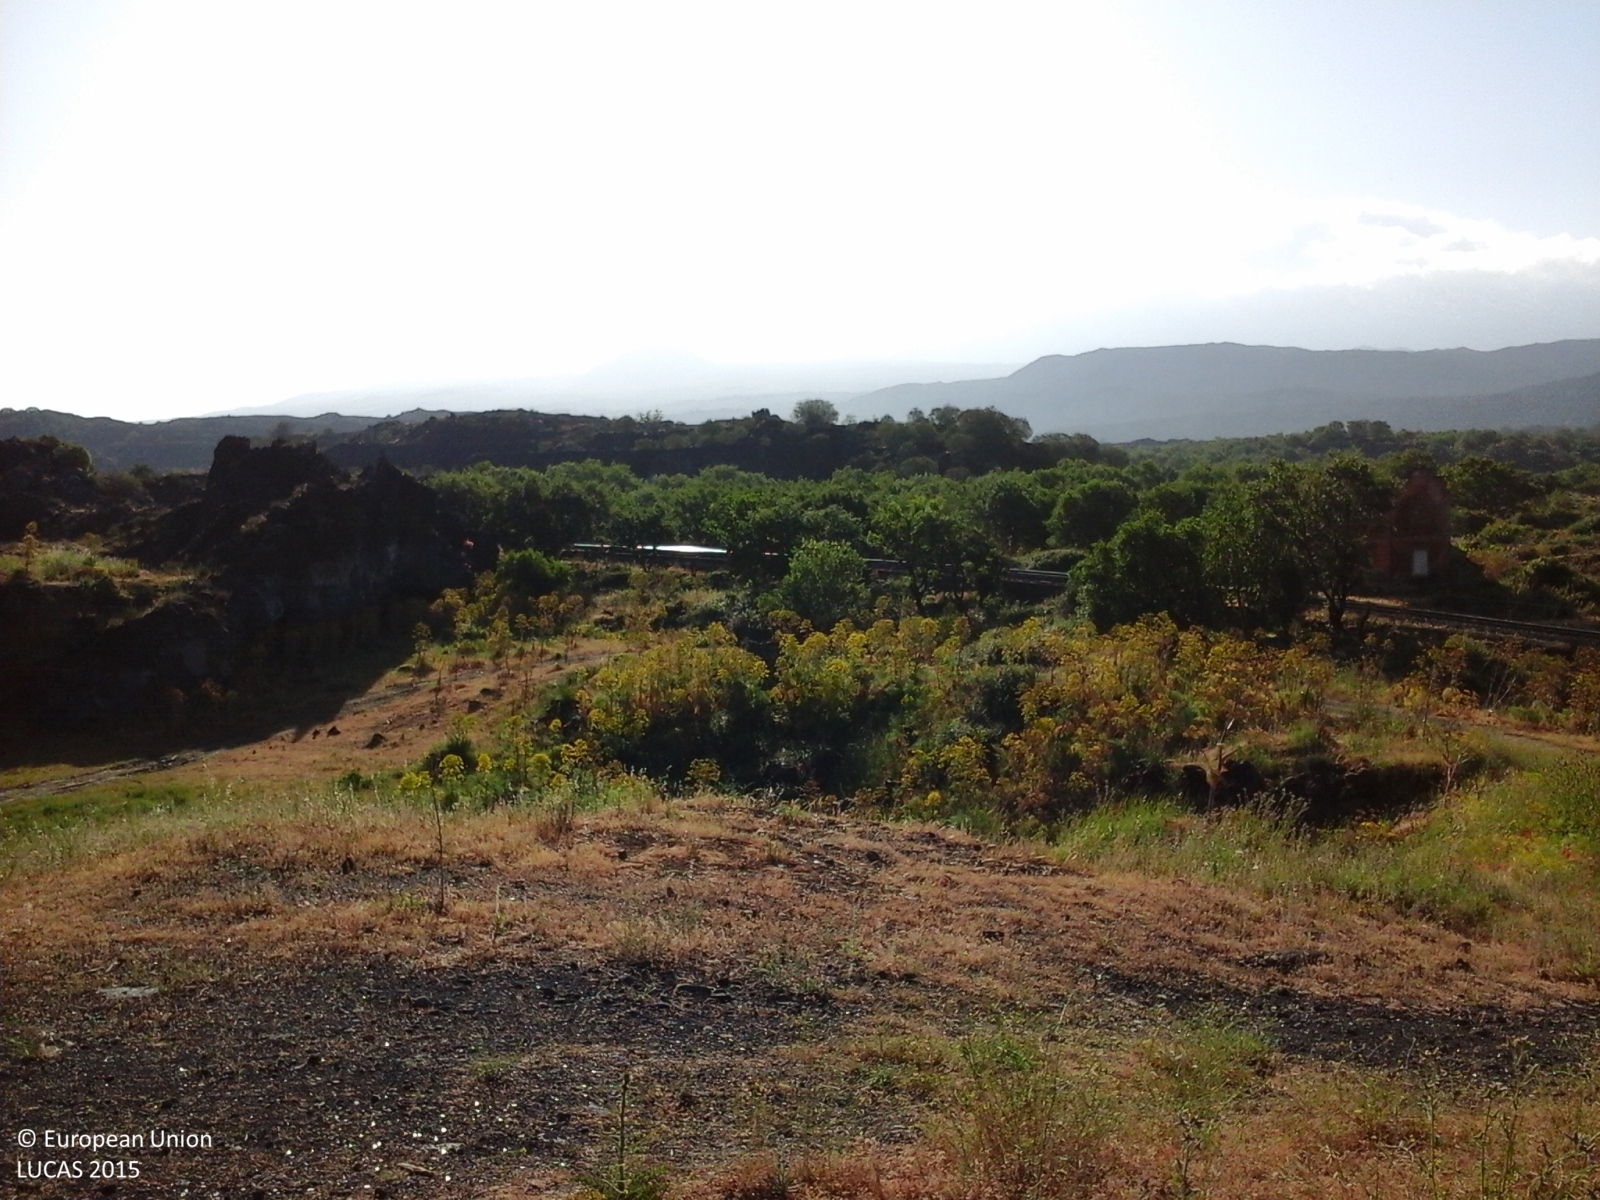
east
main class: Woodland
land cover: Broadleaved woodland
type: thermophilous deciduous forest
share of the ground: > 75 %
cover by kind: broadleaved forest trees 100 %
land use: Forestry
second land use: Amenities, museums, leisure
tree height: > 5 m
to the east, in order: Broadleaved woodland; Rocks and stones
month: May
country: IT
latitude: 37.7869
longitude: 14.8604
